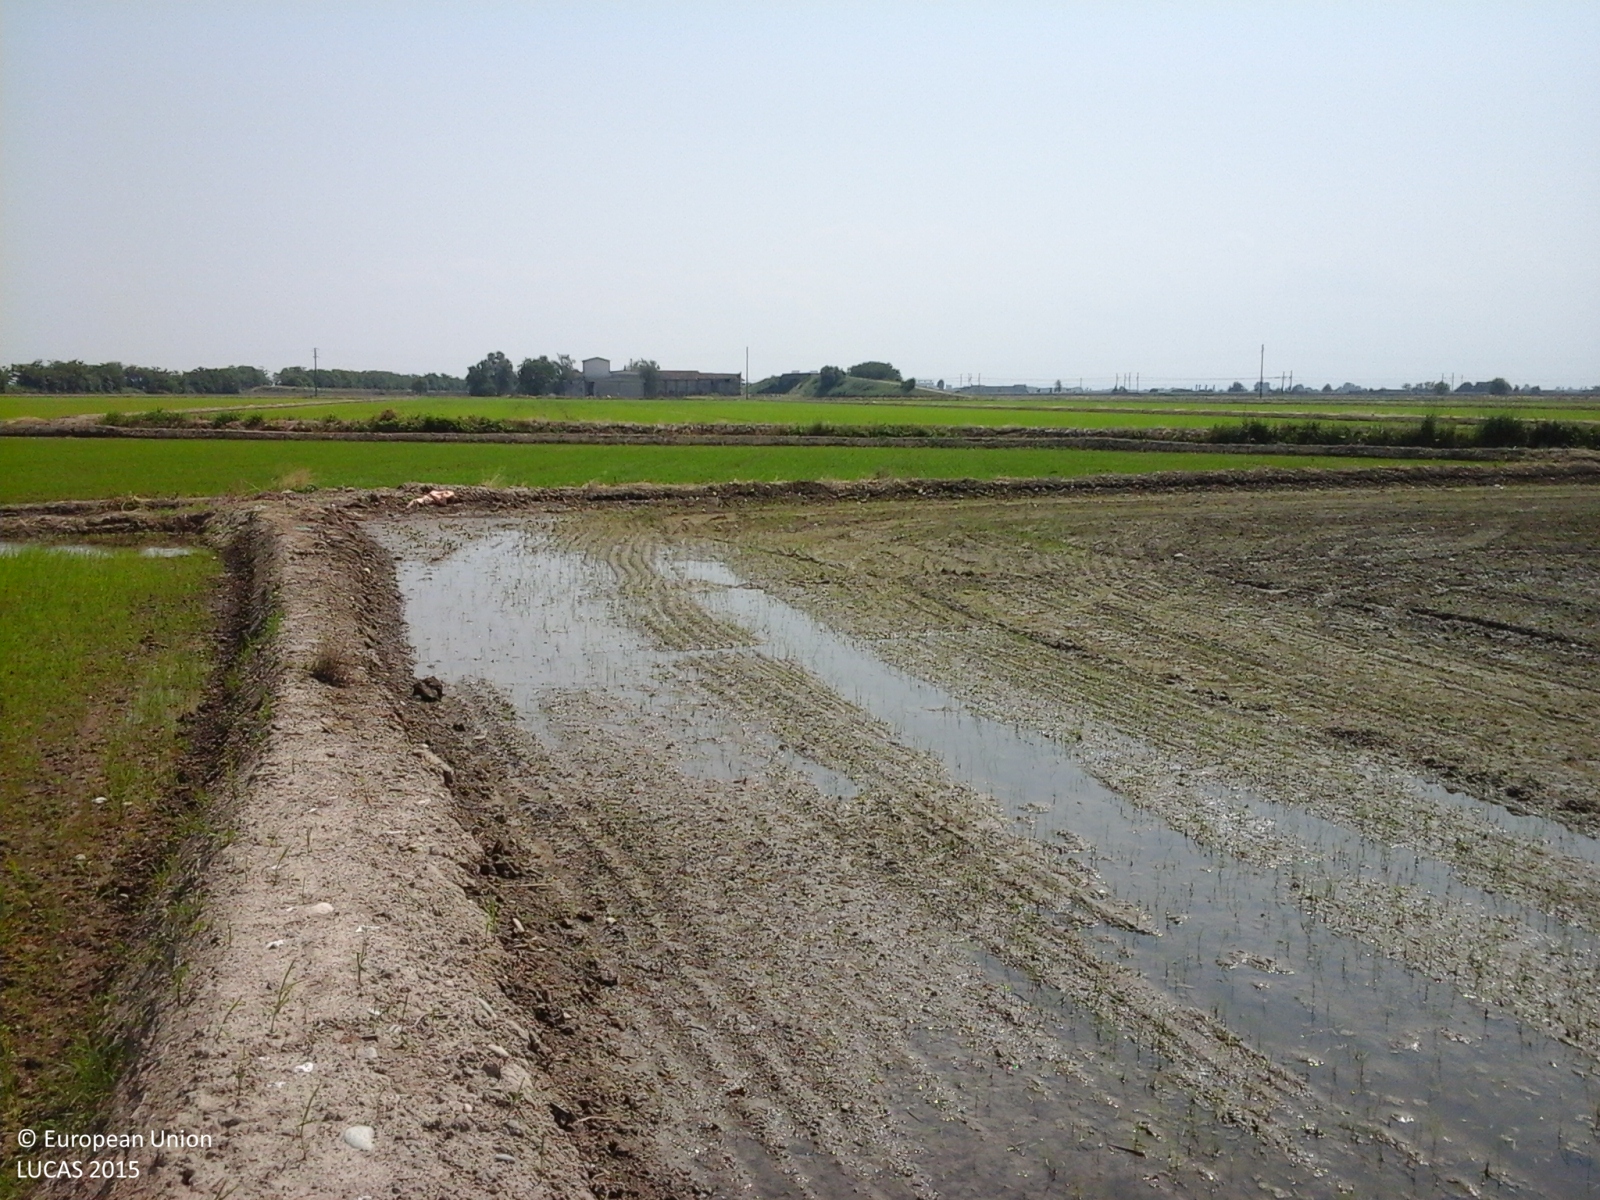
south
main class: Cropland
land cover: Rice
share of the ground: 25 - 50 %
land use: Agriculture (excluding fallow land and kitchen gardens)
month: May
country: IT
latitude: 45.3634
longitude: 8.2284
